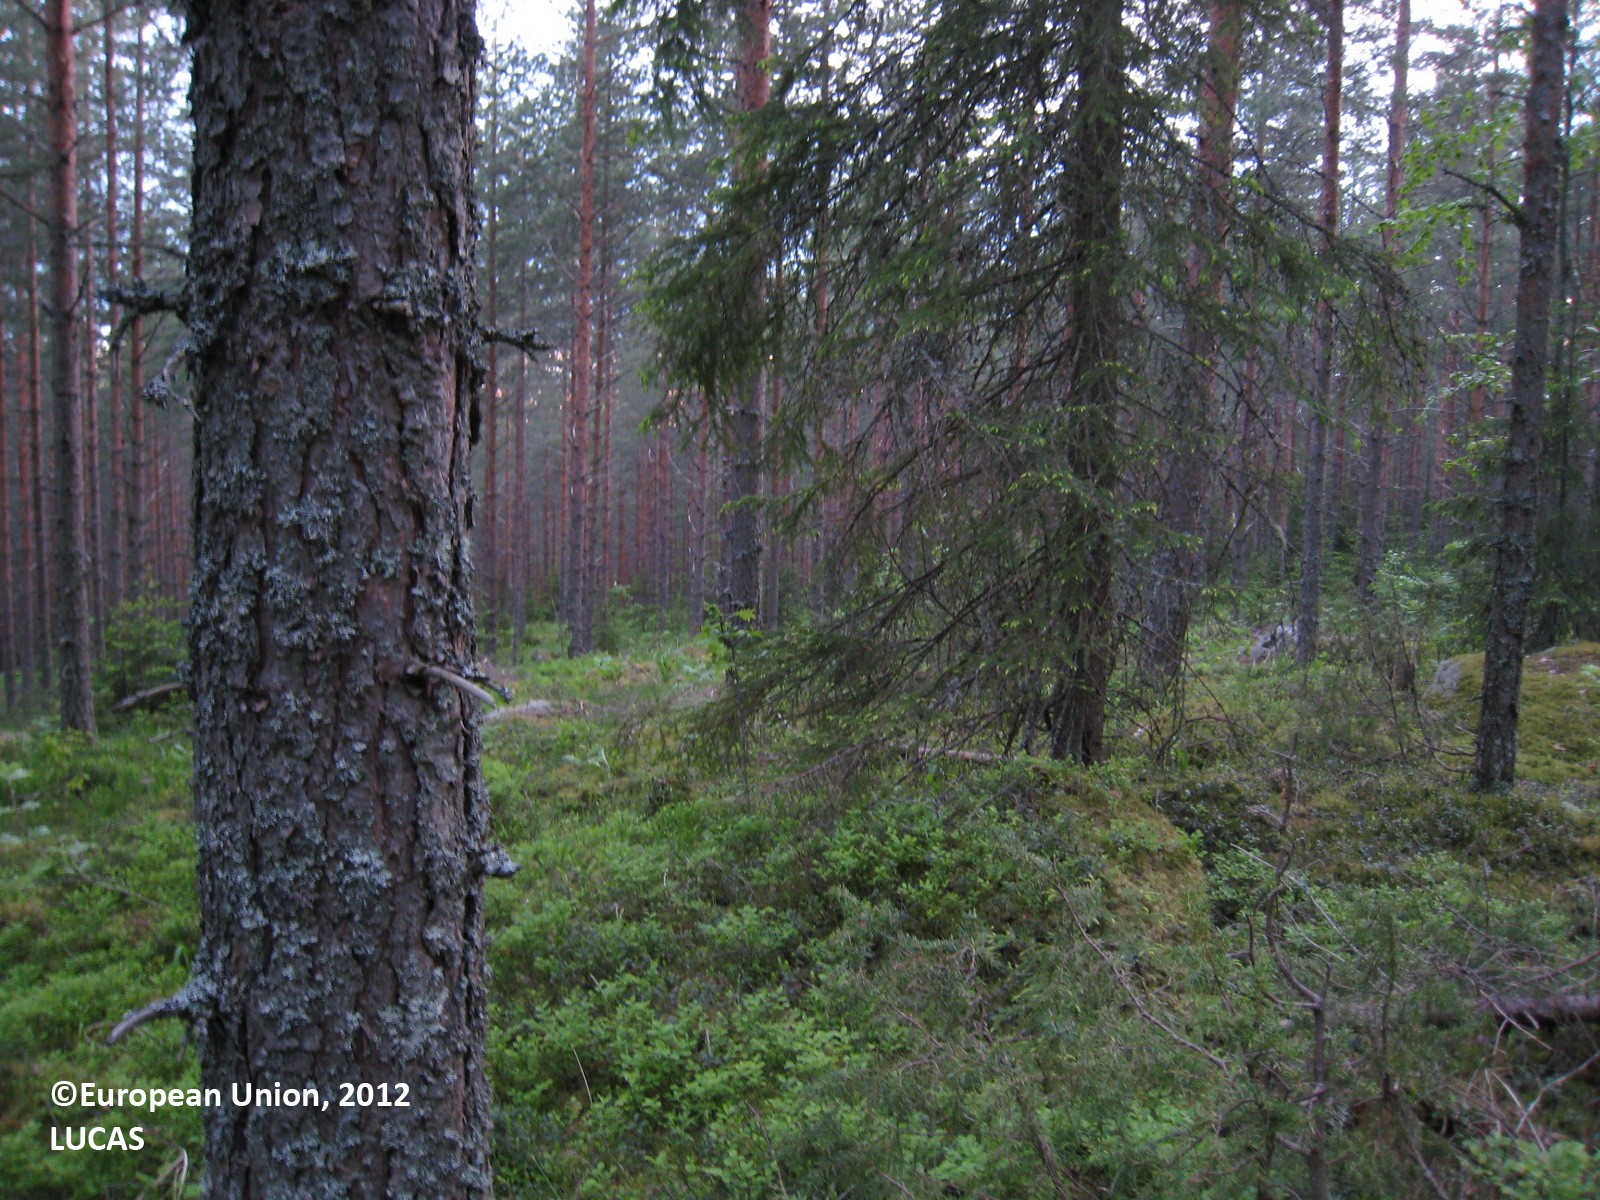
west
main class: Woodland
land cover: Pine dominated coniferous woodland
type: boreal forest
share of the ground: 50 - 75 %
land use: Forestry
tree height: > 5 m
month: June
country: FI
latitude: 62.5594
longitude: 26.0156
